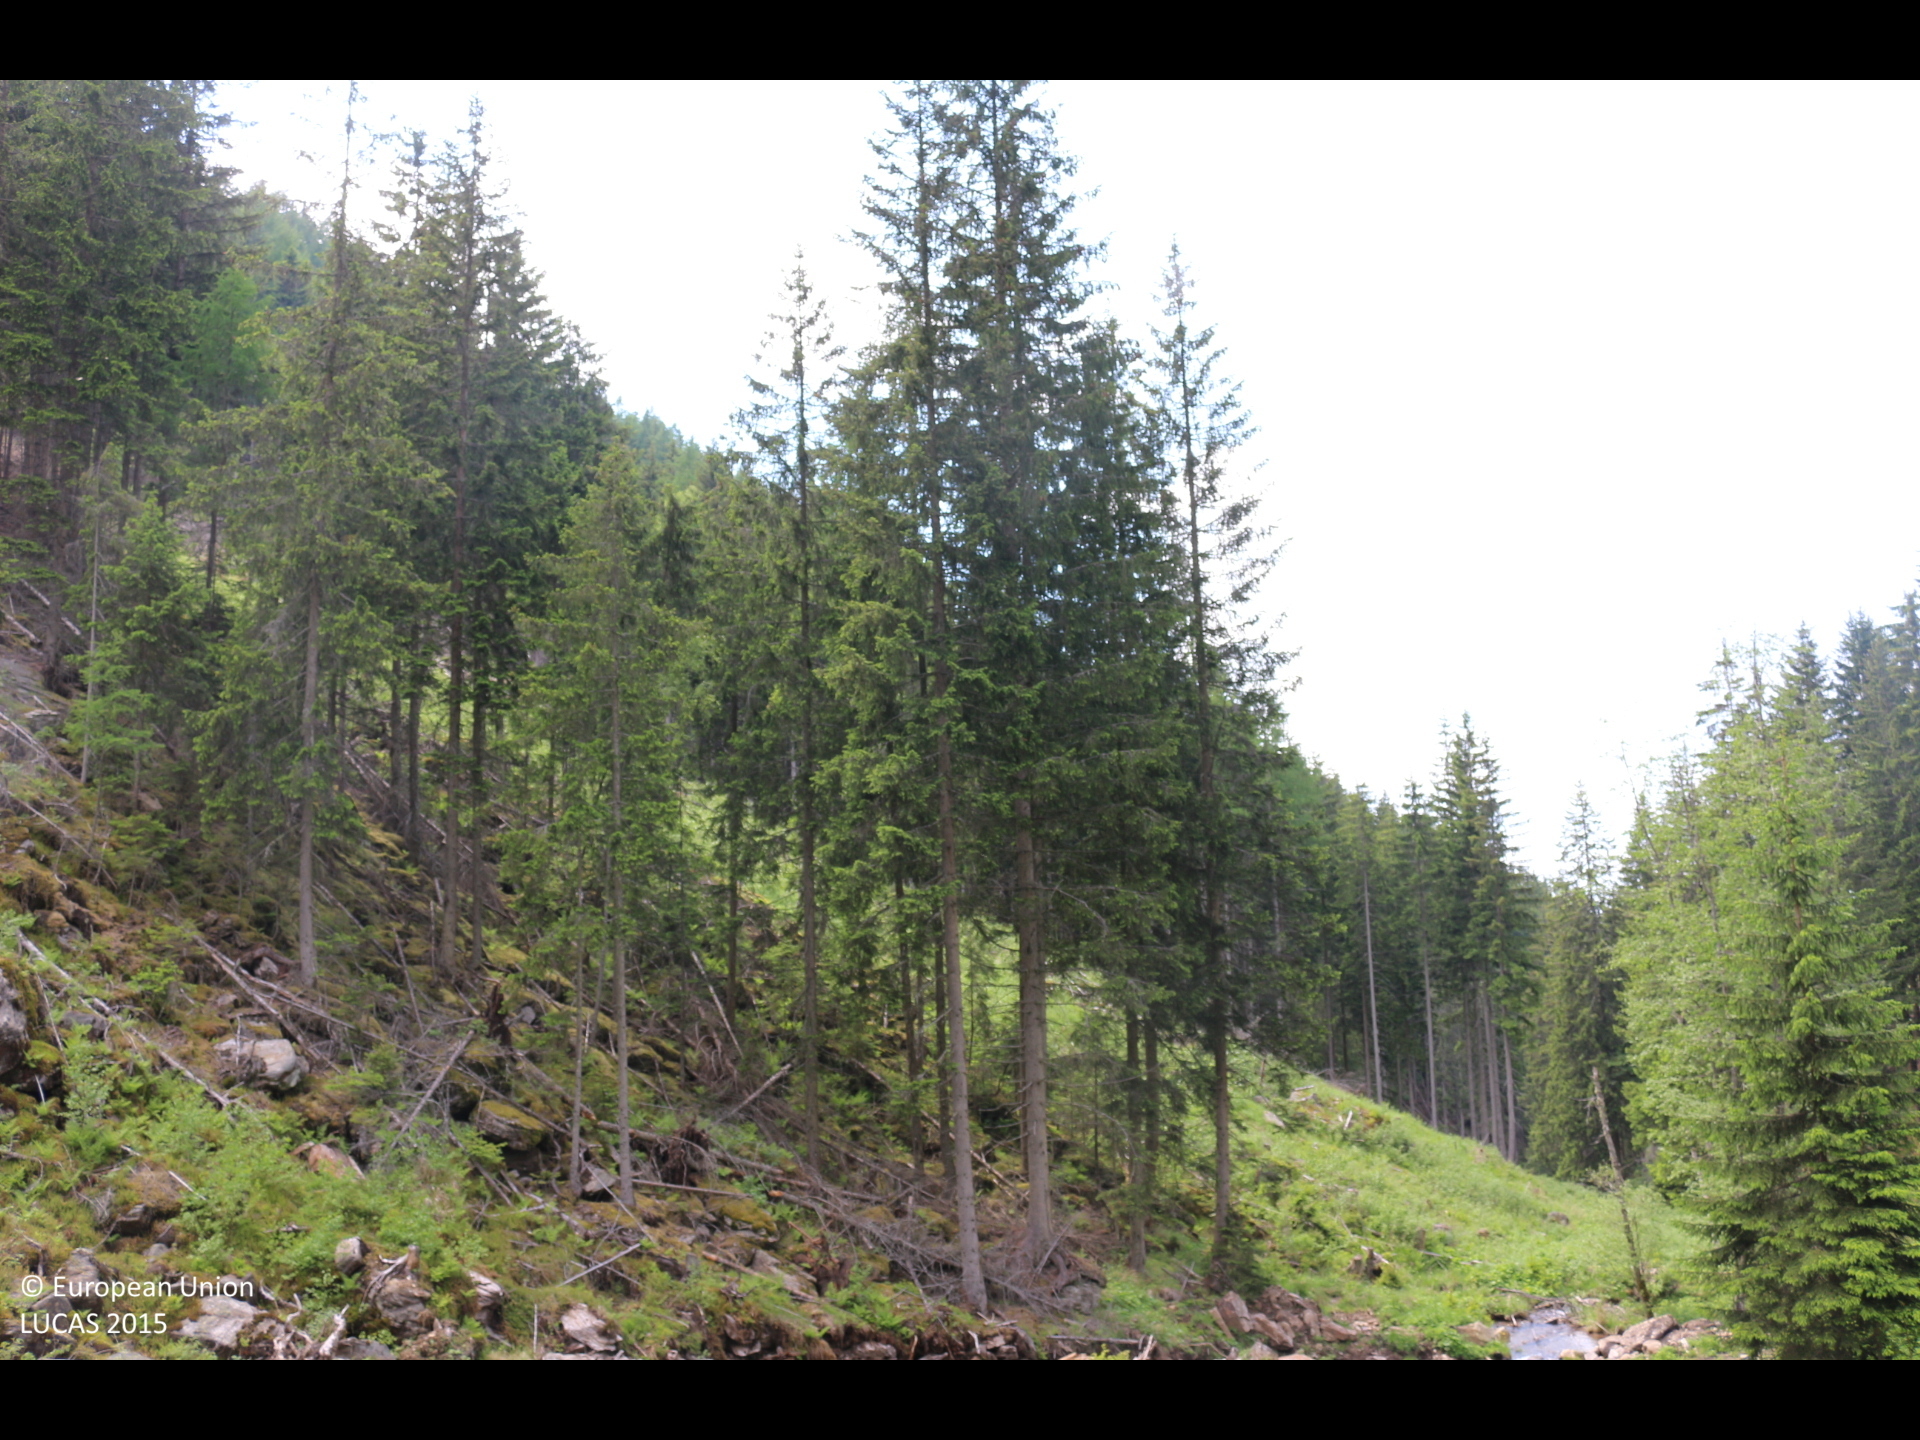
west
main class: Shrubland
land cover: Shrubland without tree cover
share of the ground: 50 - 75 %
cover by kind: shrubs 65 %, herbaceous plants 25 %, consolidated bare surface 10 %
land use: Forestry
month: June
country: AT
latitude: 46.8475
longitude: 14.6011
